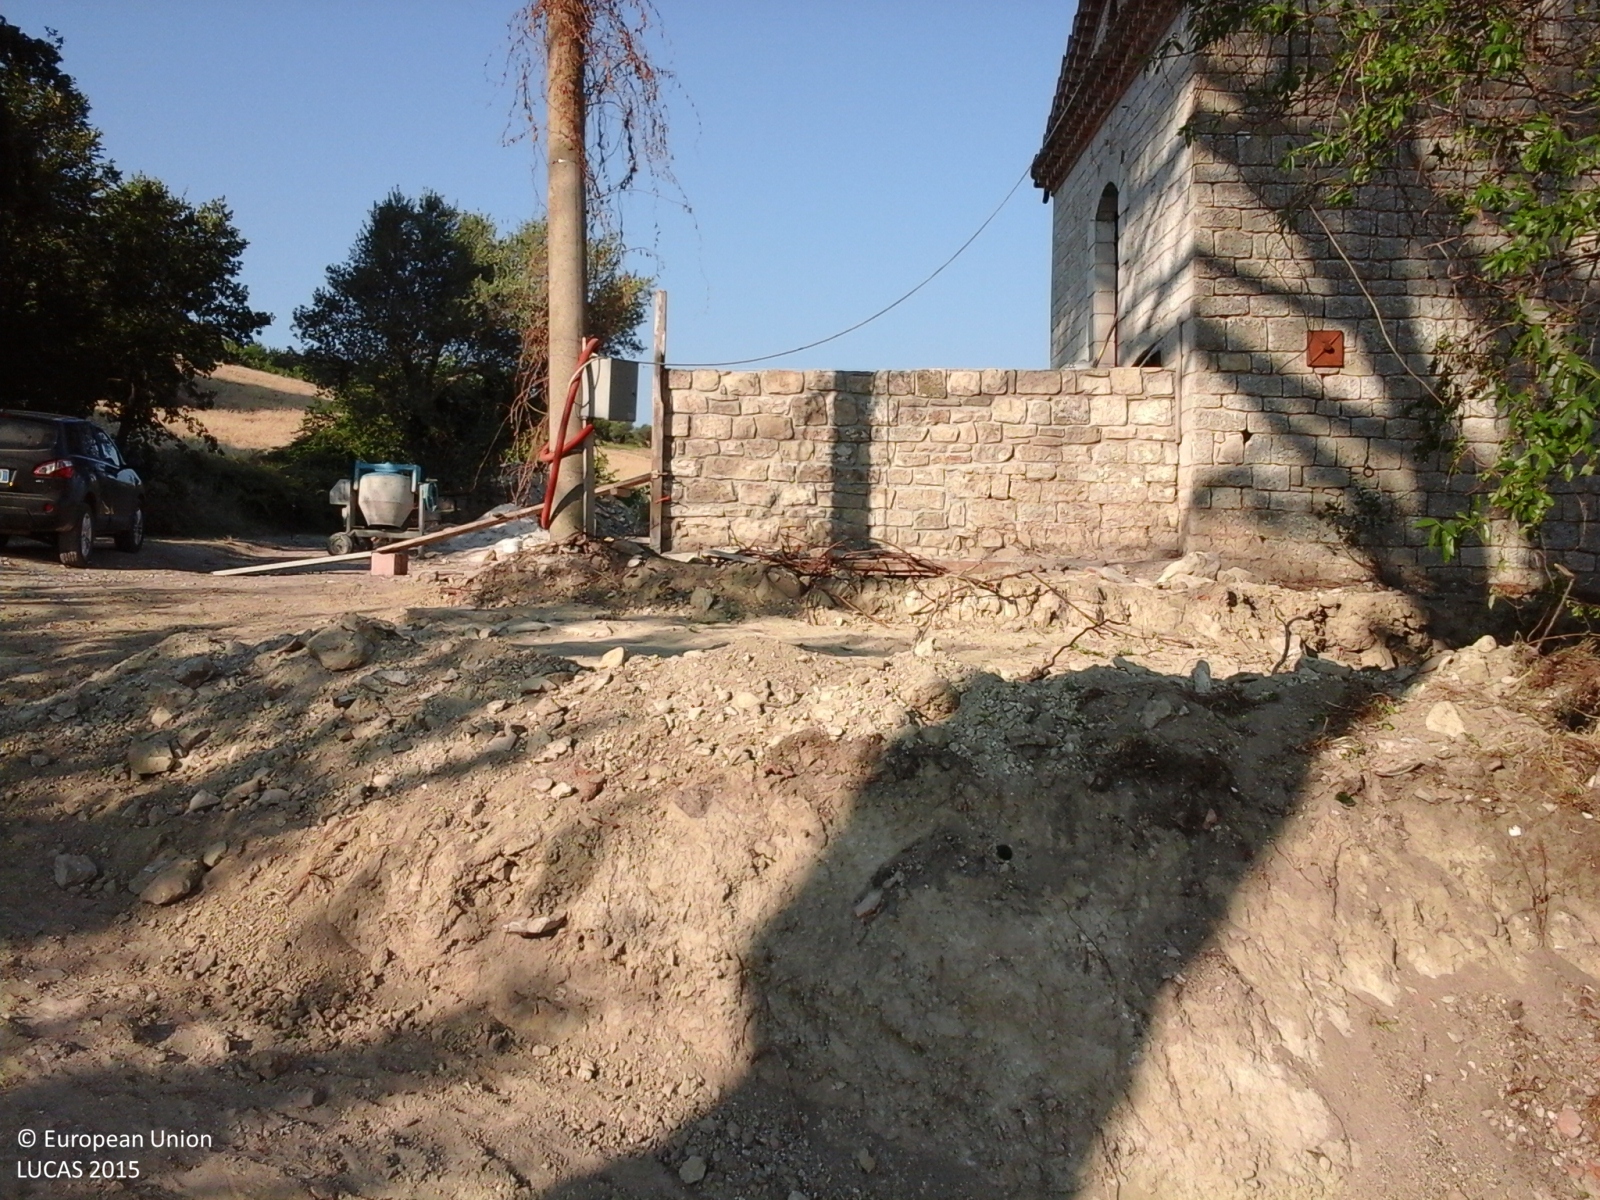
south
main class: Woodland
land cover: Broadleaved woodland
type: thermophilous deciduous forest
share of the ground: > 75 %
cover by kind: broadleaved forest trees 75 %, shrubs 15 %, herbaceous plants 10 %
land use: Semi-natural and natural areas not in use
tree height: > 5 m
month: July
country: IT
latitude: 41.6603
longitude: 14.6557
